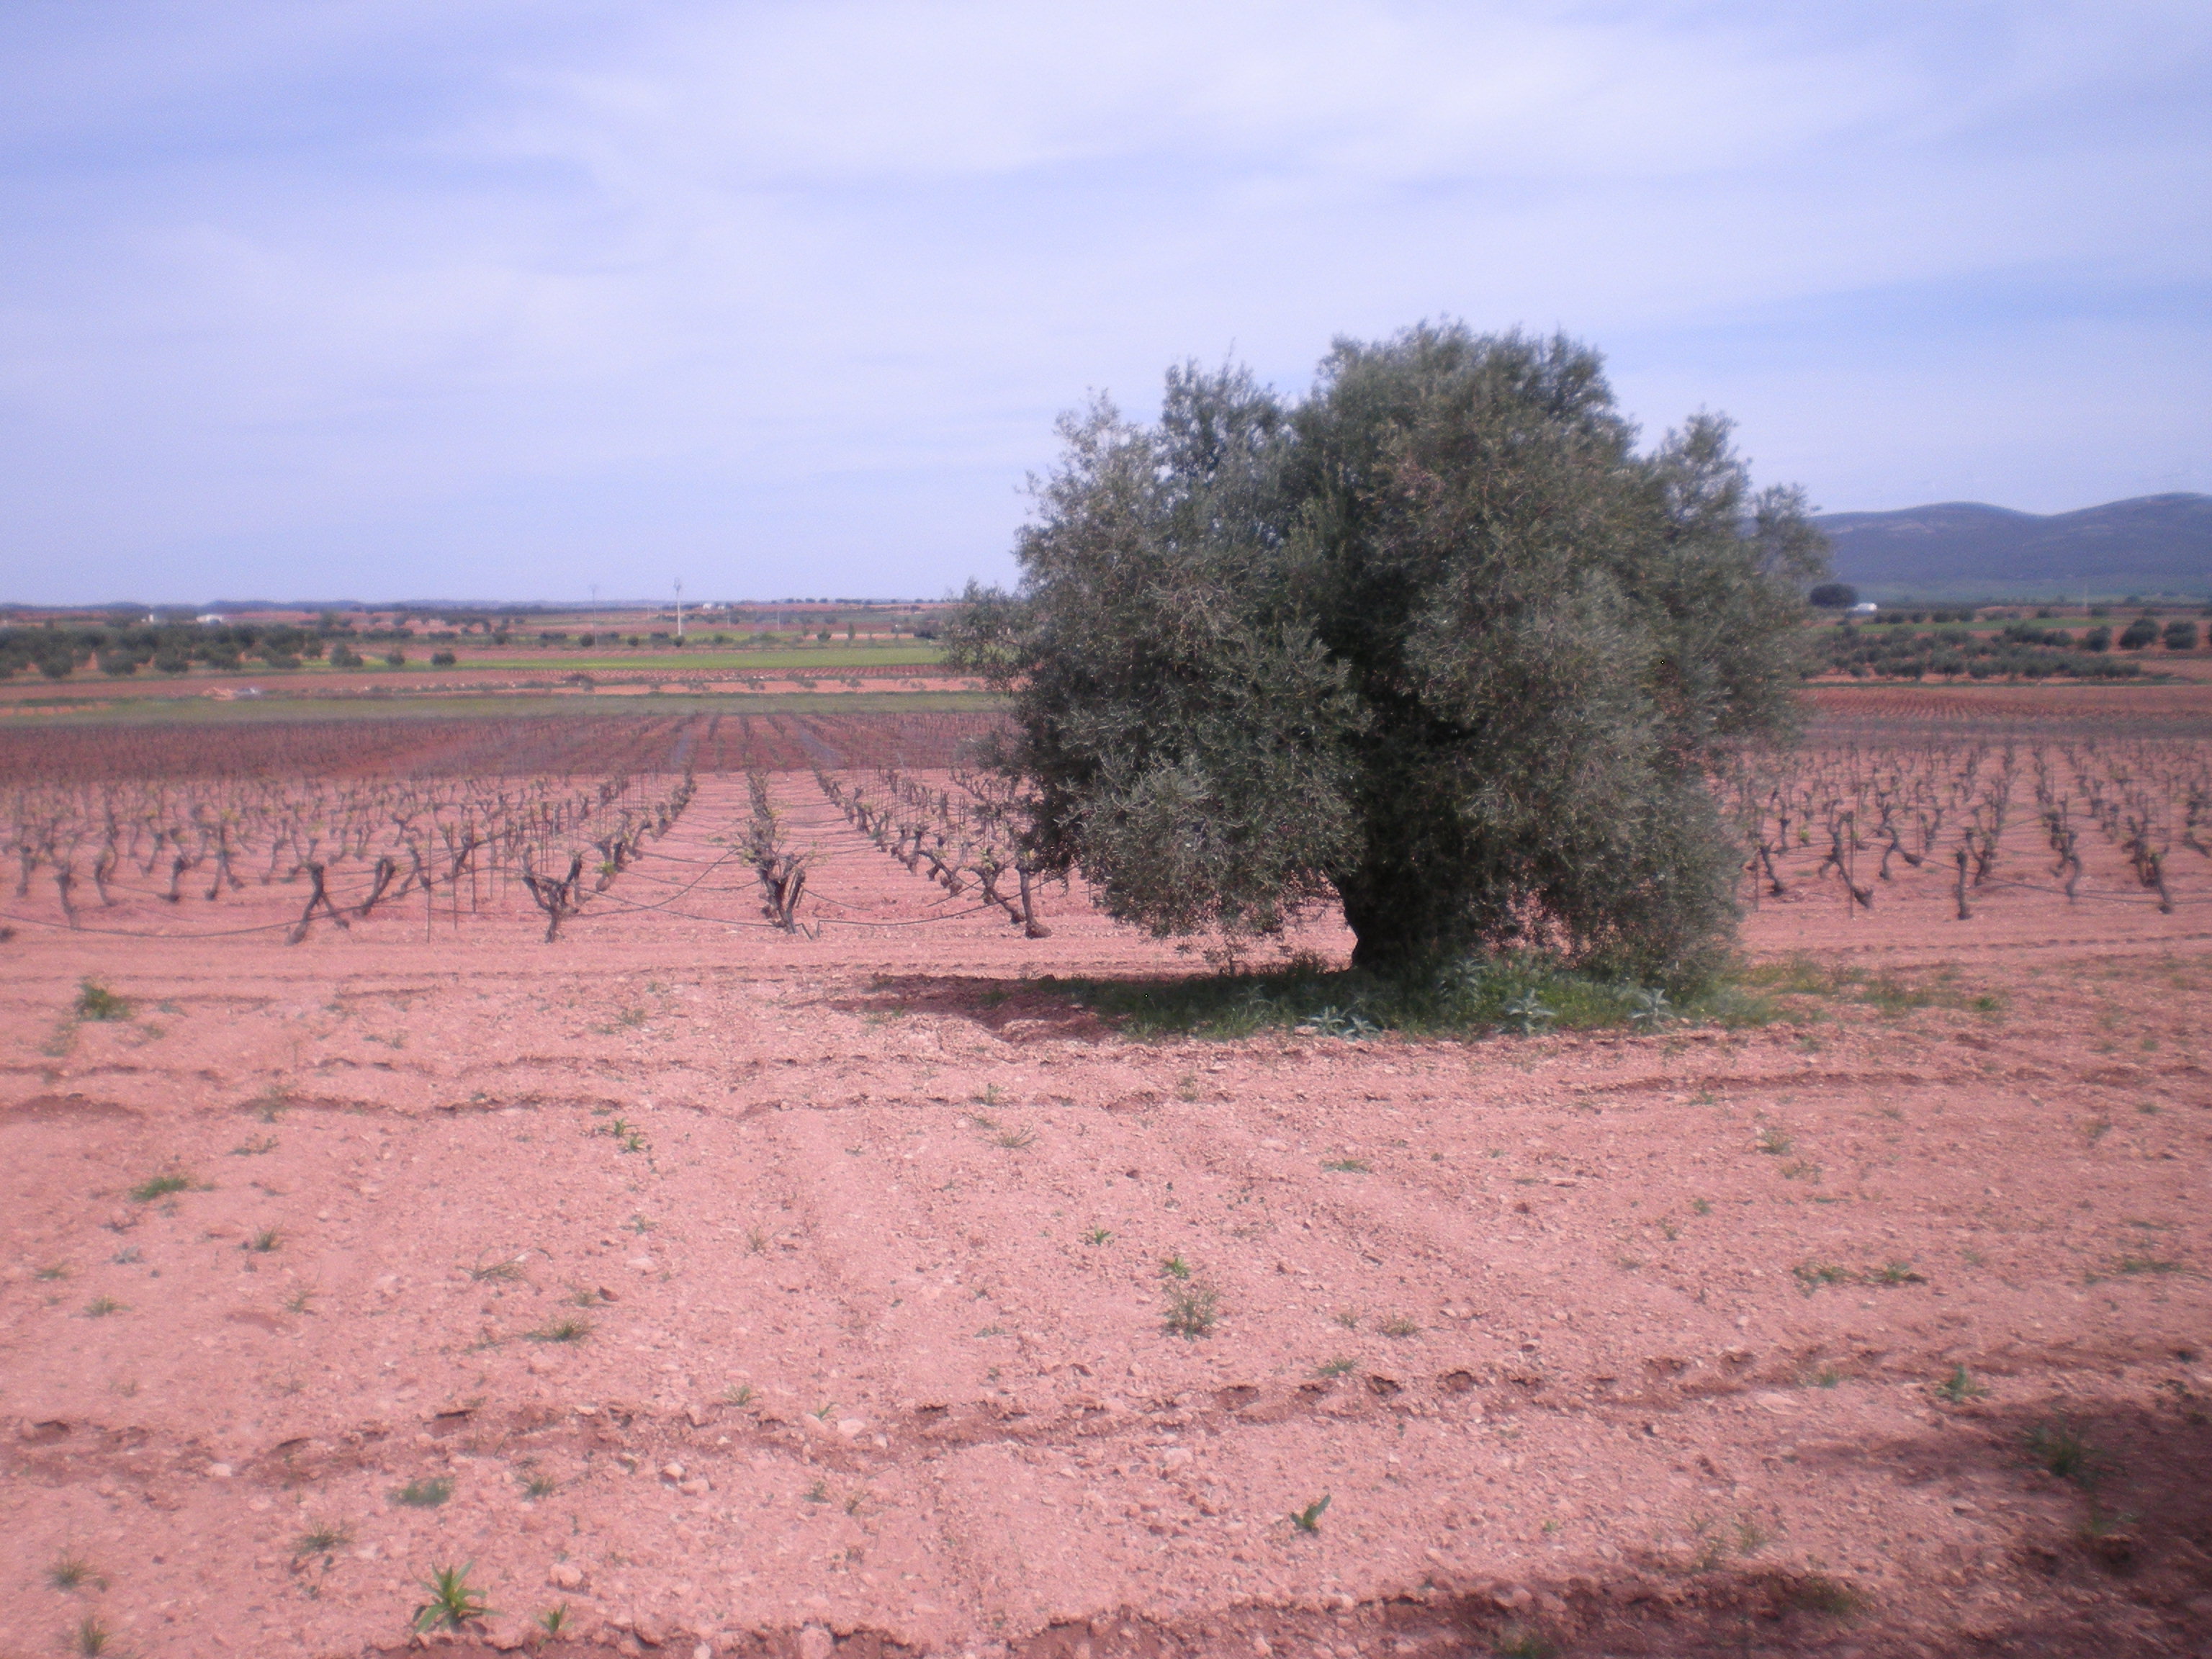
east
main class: Cropland
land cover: Olive groves
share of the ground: 10 - 25 %
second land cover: Other bare soil
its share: > 75 %
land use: Agriculture (excluding fallow land and kitchen gardens)
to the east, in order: Olive groves; Other bare soil; Vineyards
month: April
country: ES
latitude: 38.8933
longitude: -3.2122
